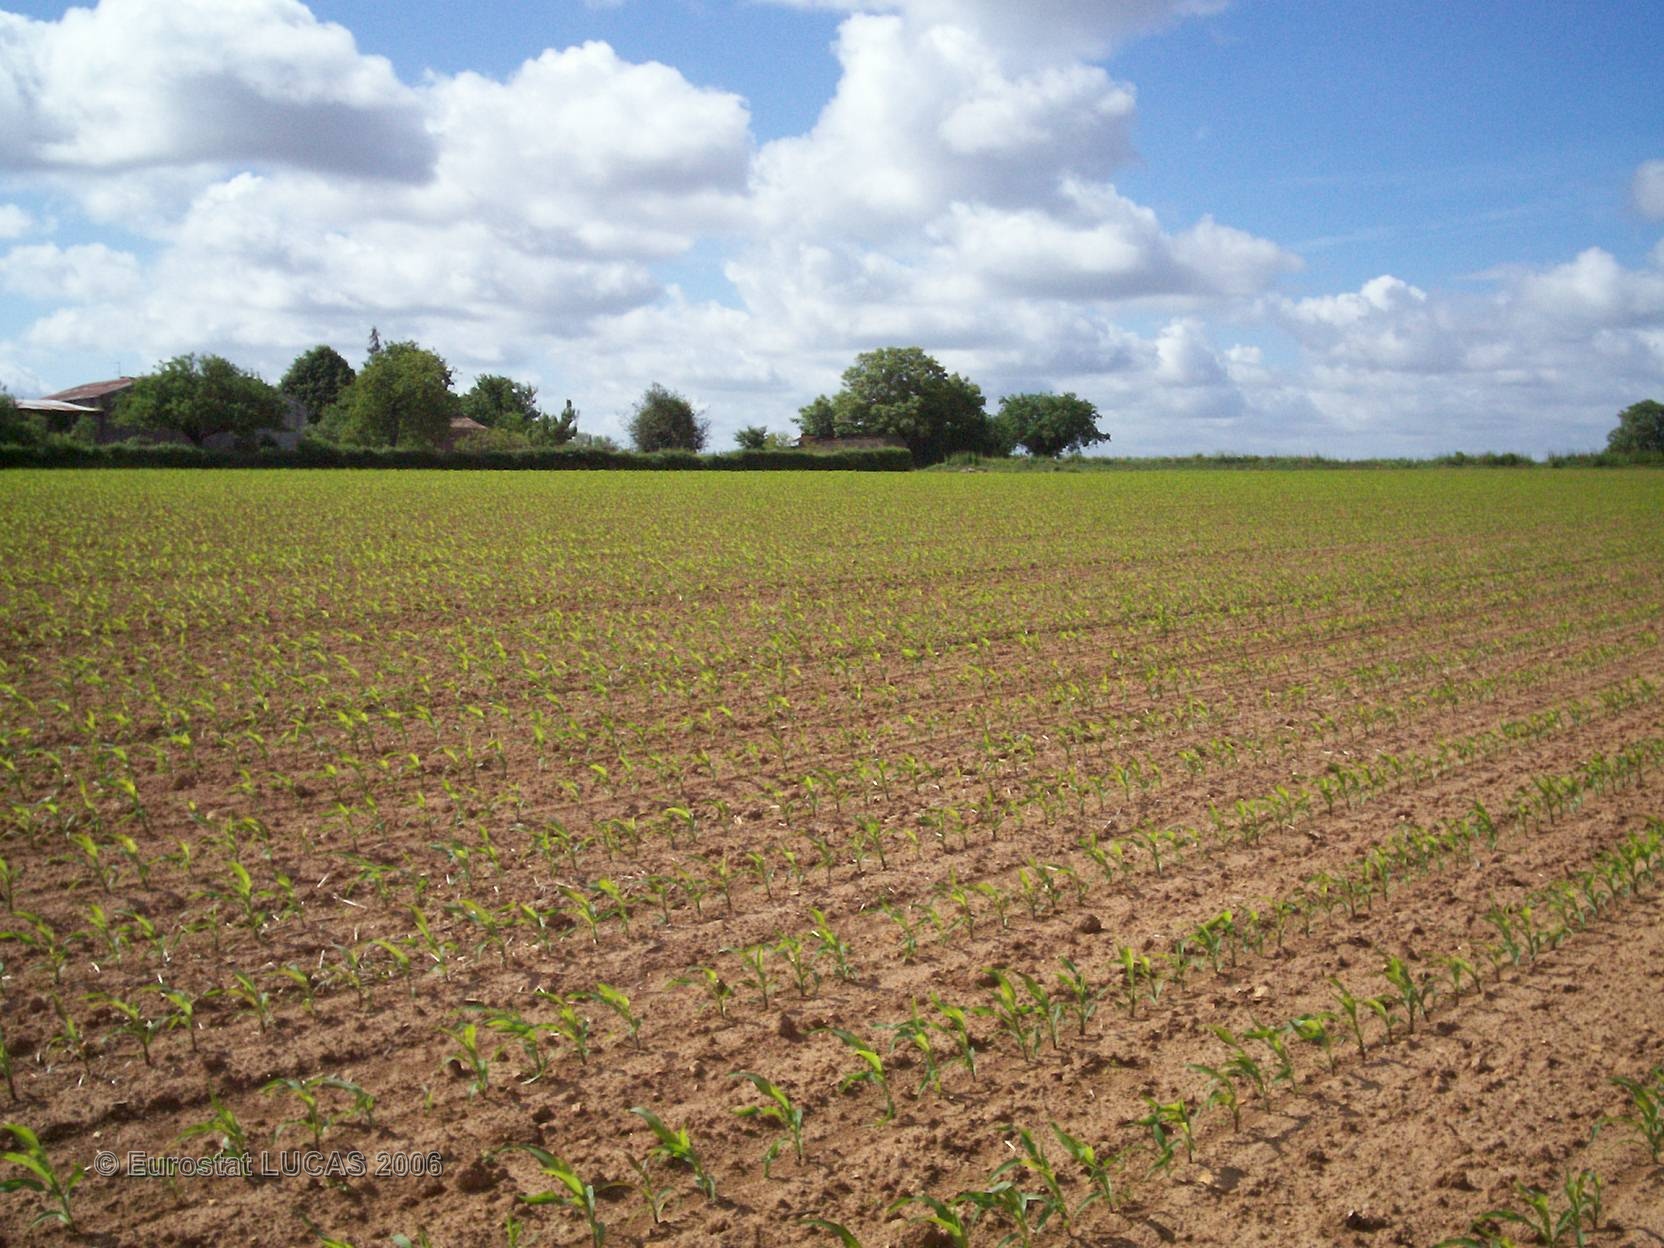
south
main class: Cropland
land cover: Maize
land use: Agriculture (excluding fallow land and kitchen gardens)
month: May
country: FR
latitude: 46.2075
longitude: -0.1965
